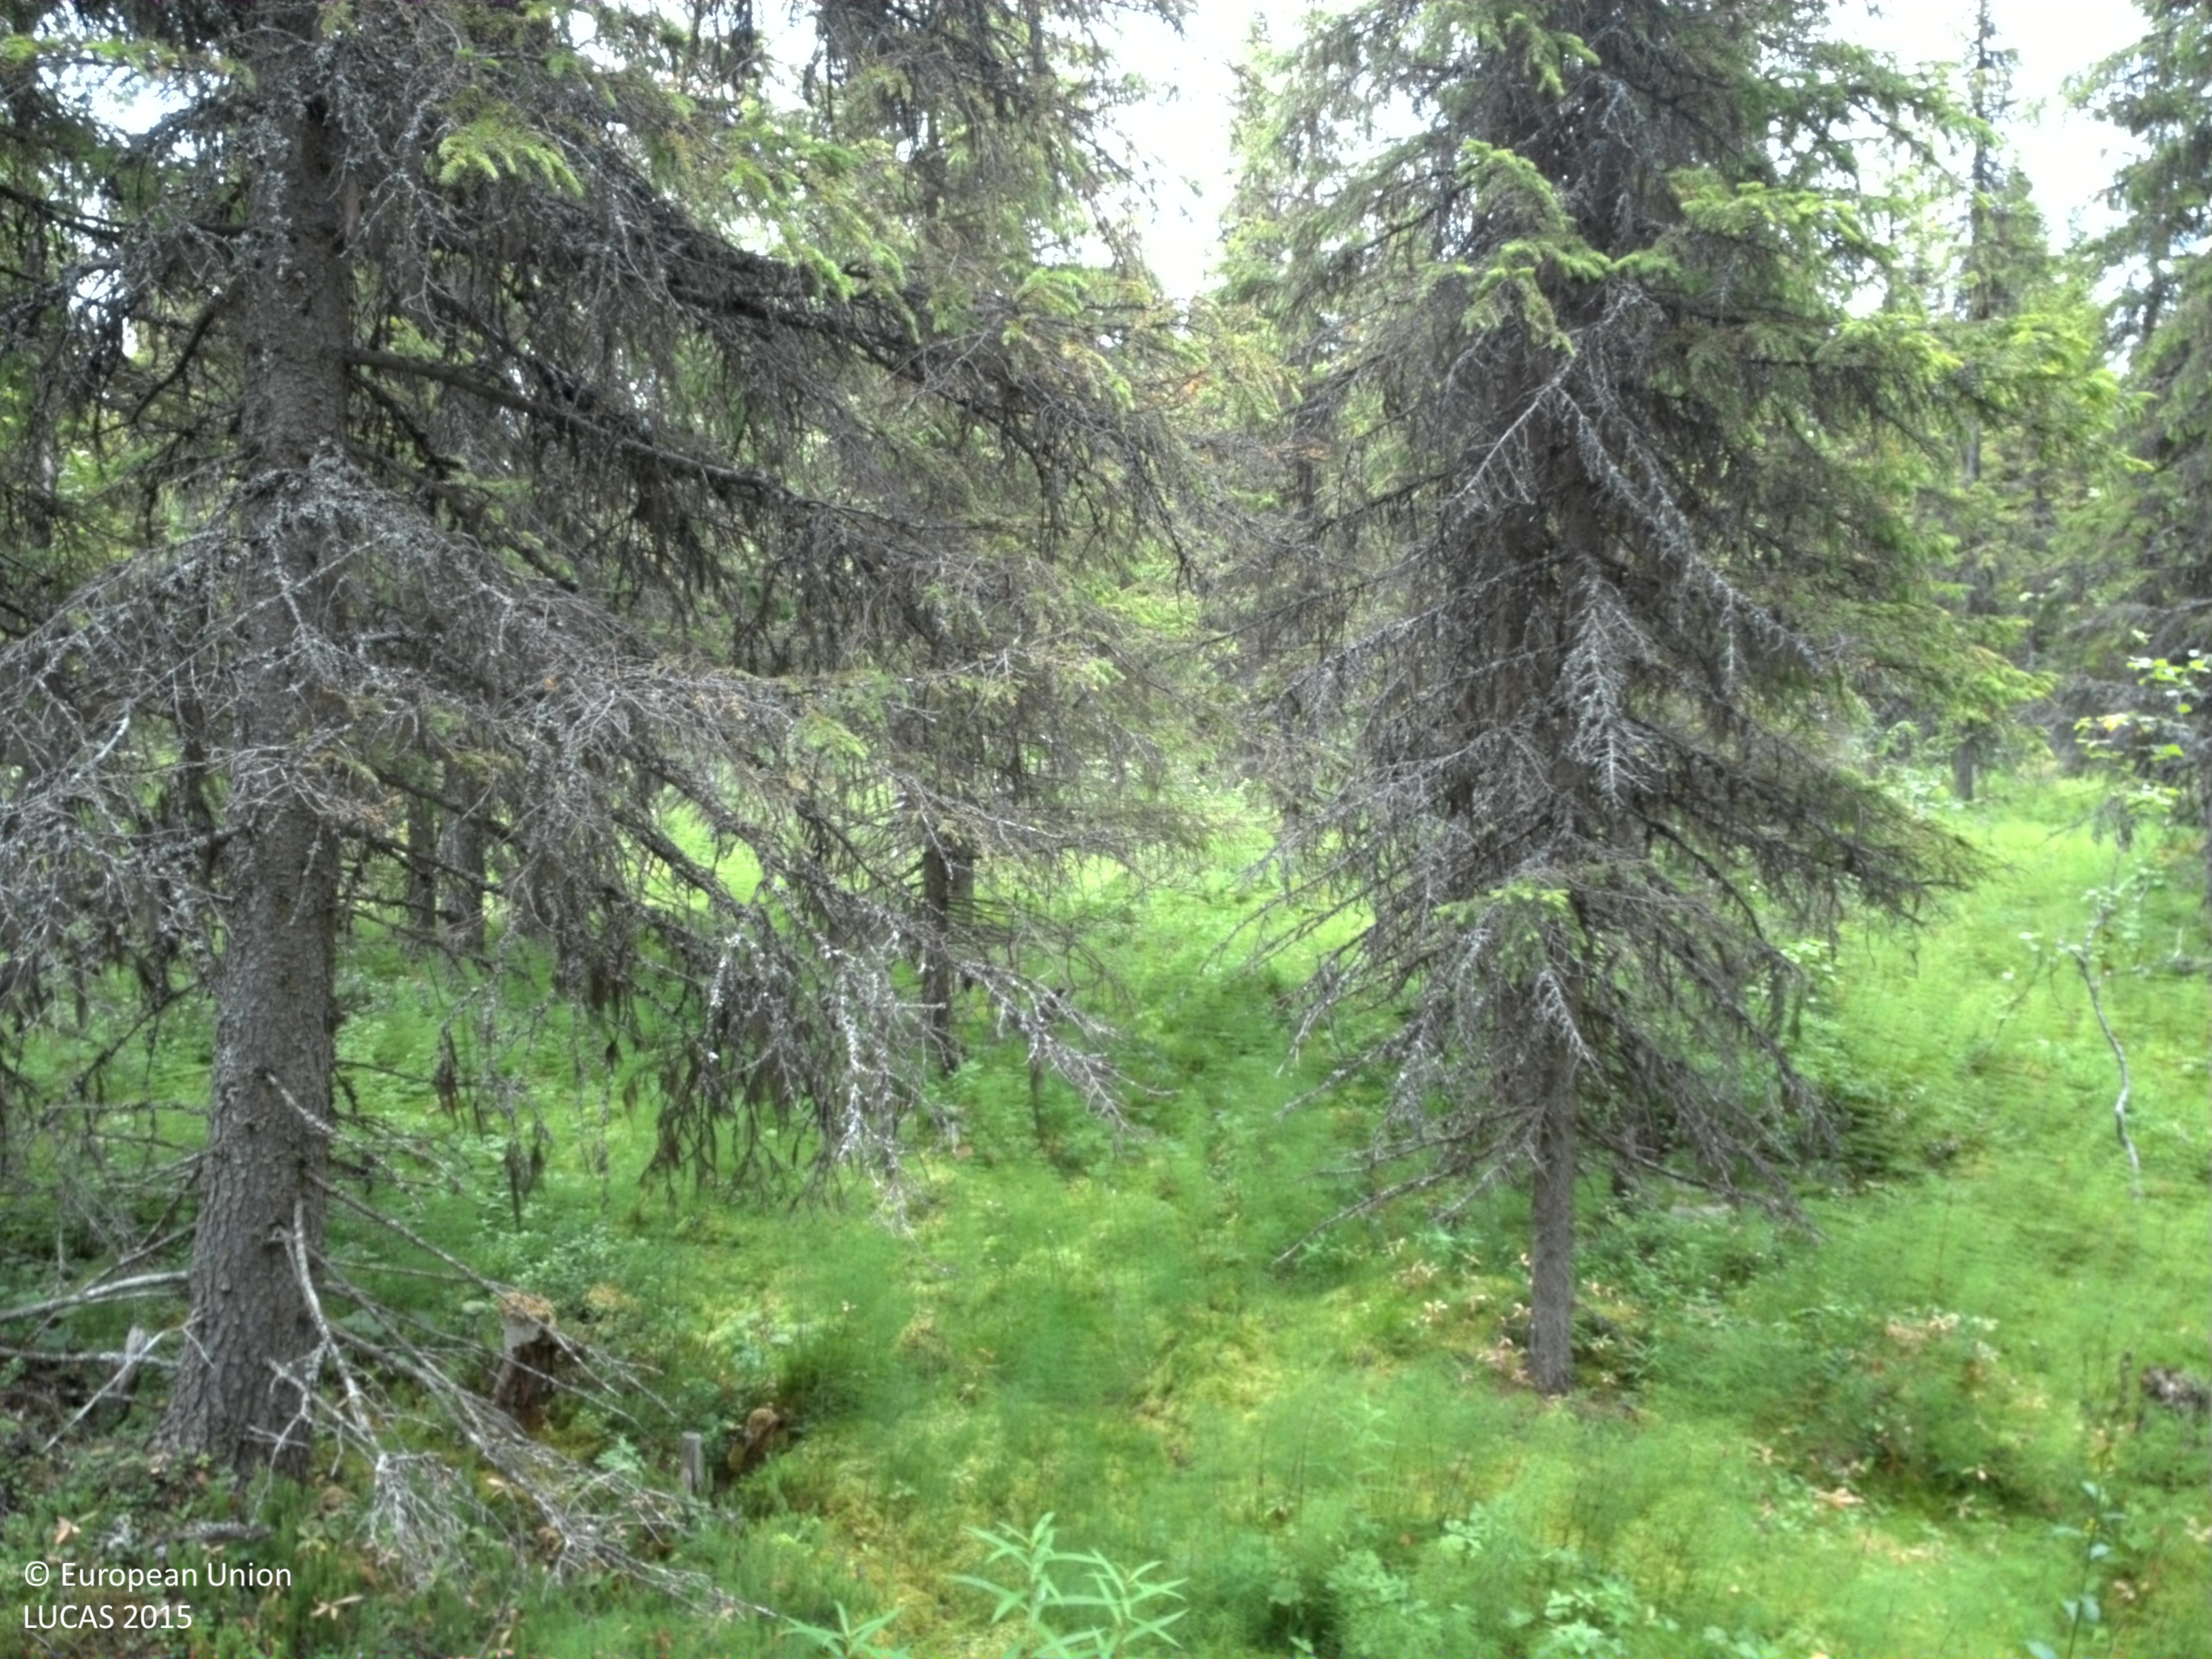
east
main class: Woodland
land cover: Spruce dominated mixed woodland
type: boreal forest
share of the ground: 25 - 50 %
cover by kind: lichens and mosses 35 %, shrubs 20 %, herbaceous plants 20 %, coniferous forest trees 15 %, broadleaved forest trees 10 %
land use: Forestry
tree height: > 5 m
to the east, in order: Spruce dominated mixed woodland; Spruce dominated coniferous woodland; Spruce dominated mixed woodland; Shrubland with sparse tree cover
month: August
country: SE
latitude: 64.8605
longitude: 16.5688
